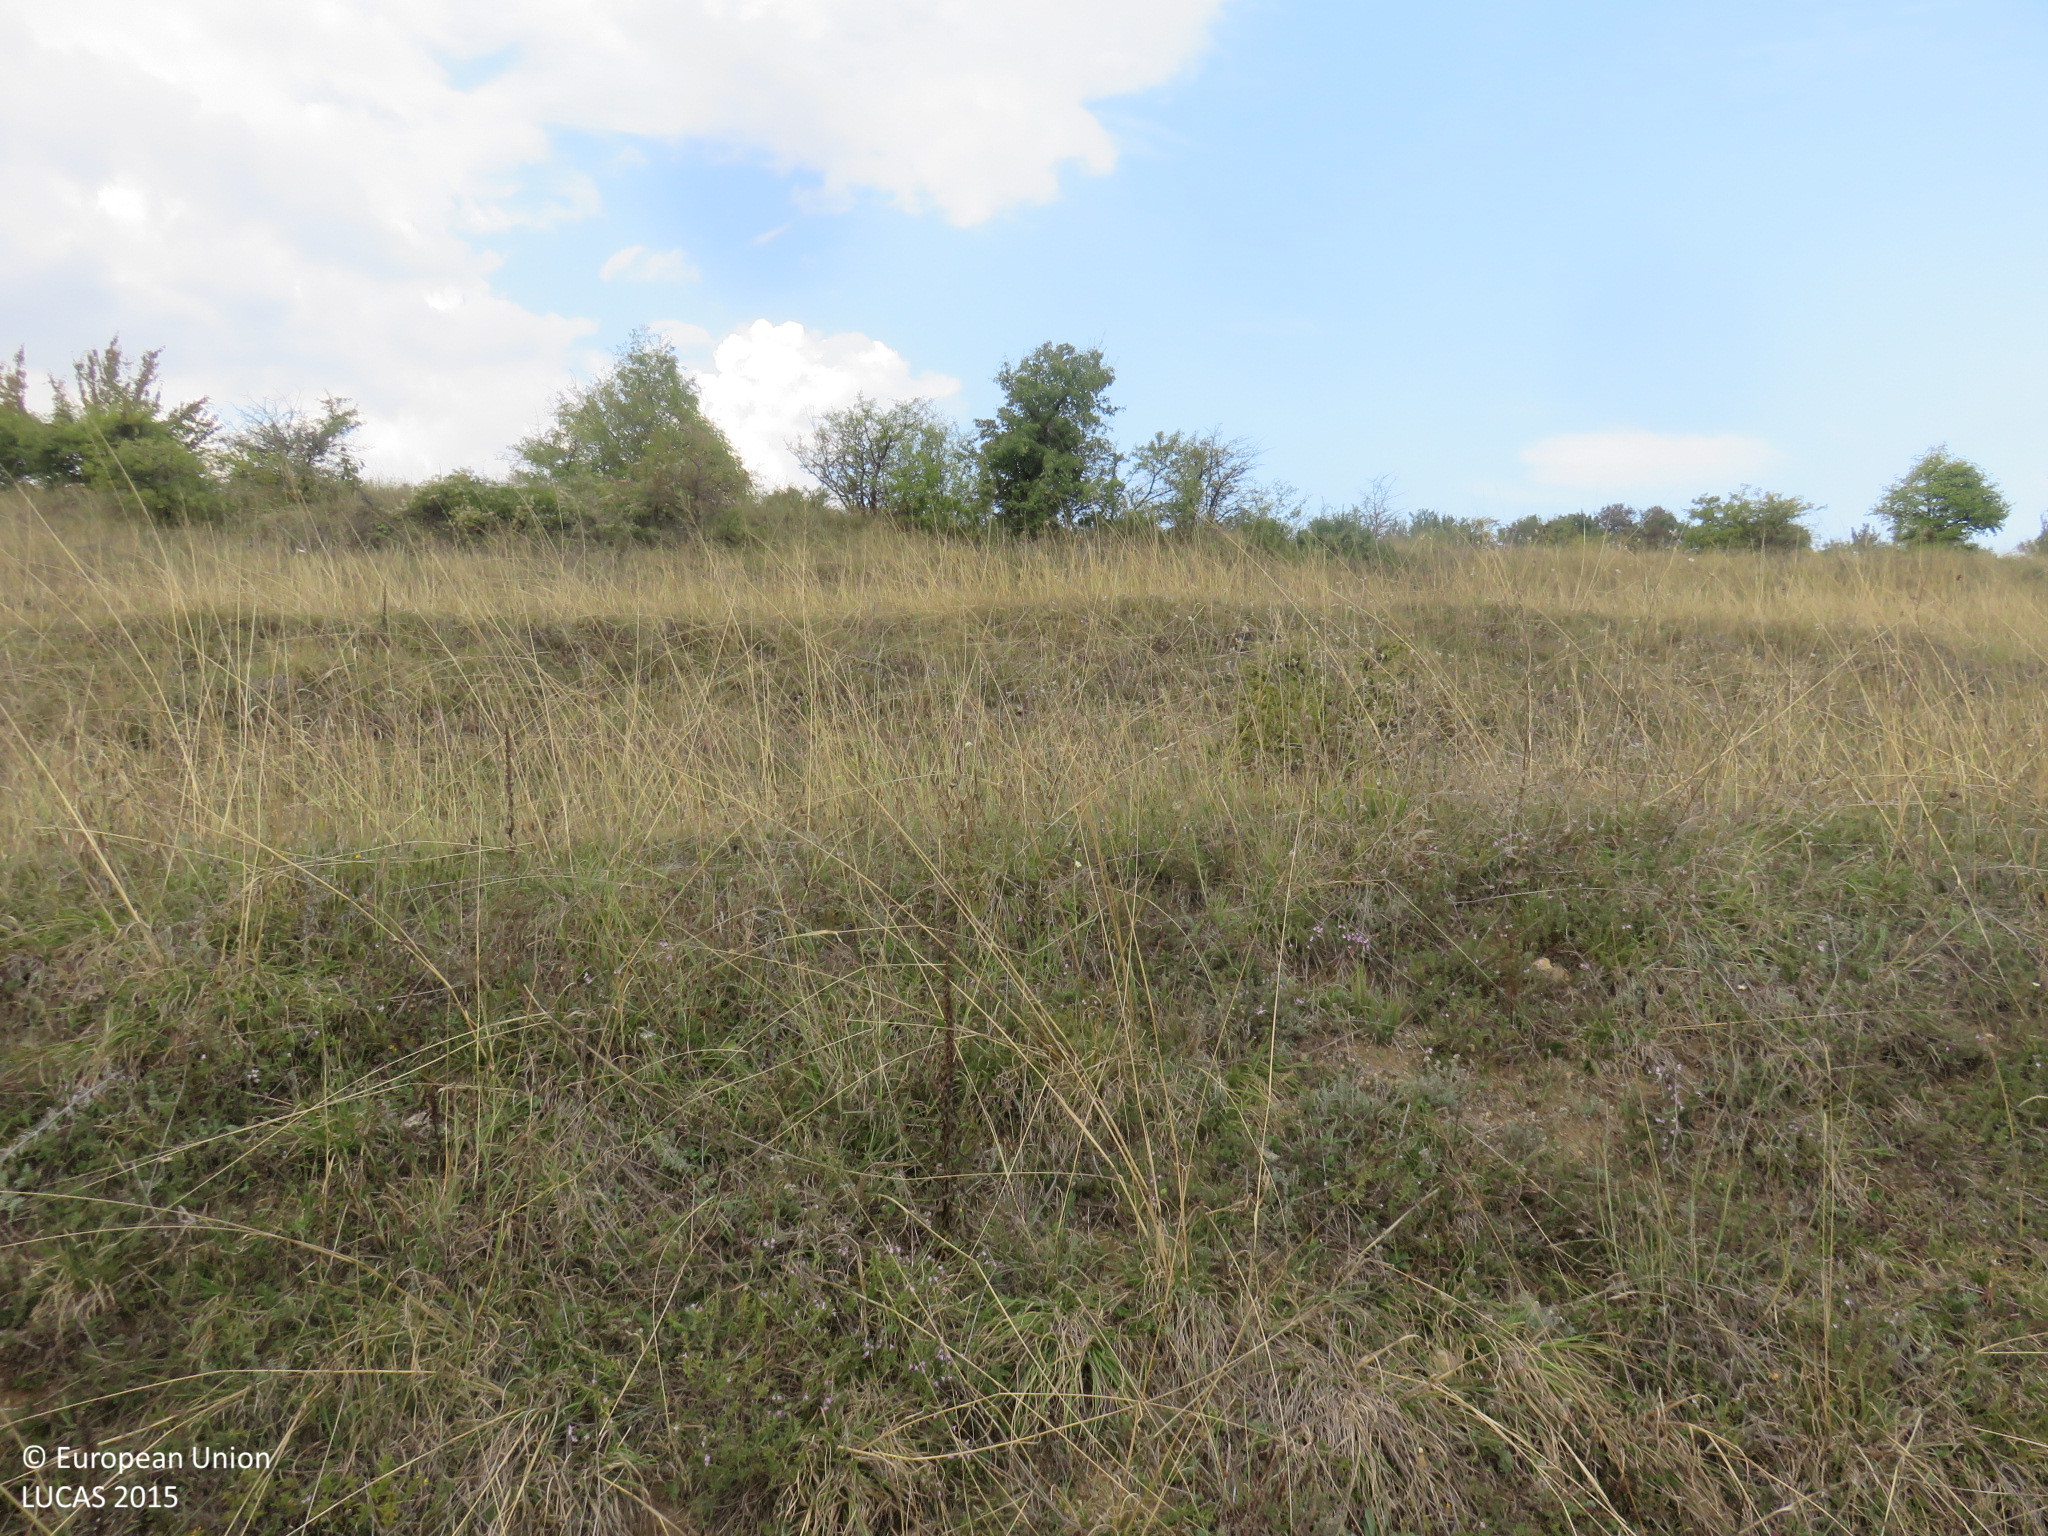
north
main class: Grassland
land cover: Grassland with sparse tree/shrub cover
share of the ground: > 75 %
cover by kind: herbaceous plants 90 %, broadleaved forest trees 5 %, shrubs 5 %
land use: Semi-natural and natural areas not in use
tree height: < 5 m
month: September
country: BG
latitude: 43.1032
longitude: 25.0210
